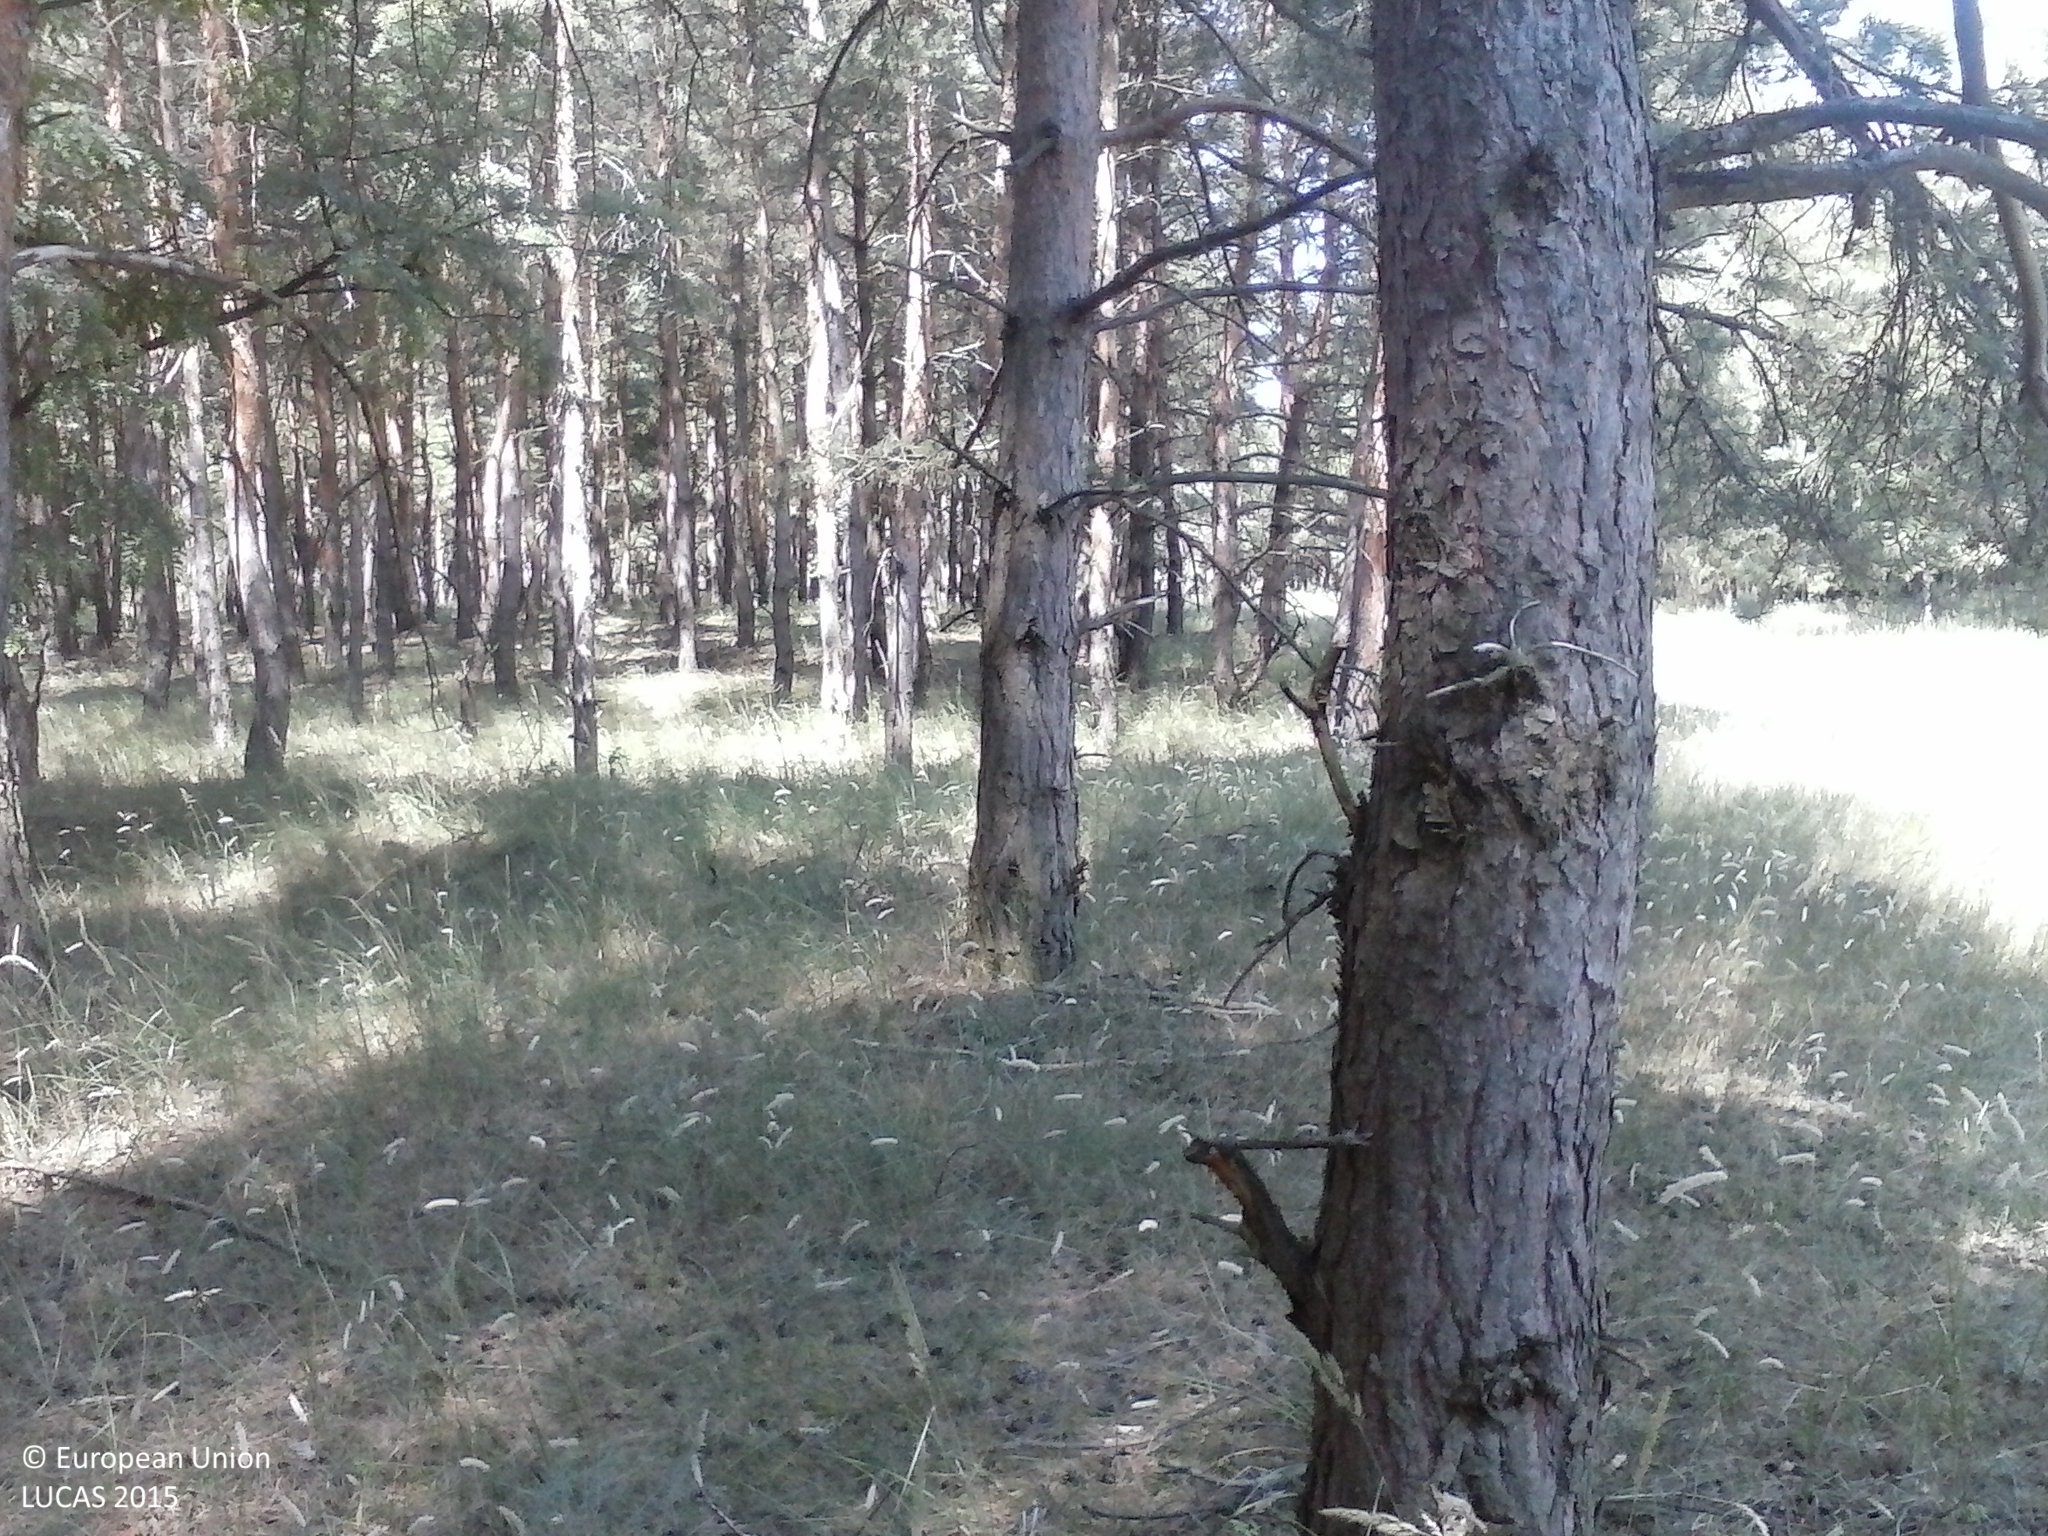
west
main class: Woodland
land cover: Pine dominated coniferous woodland
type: hemiboreal forest and nemoral coniferous forest and mixed broadleaved-coniferous forest
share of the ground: > 75 %
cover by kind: coniferous forest trees 90 %, shrubs 5 %, herbaceous plants 5 %
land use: Forestry
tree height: > 5 m
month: July
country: HU
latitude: 46.2804
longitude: 19.6082
